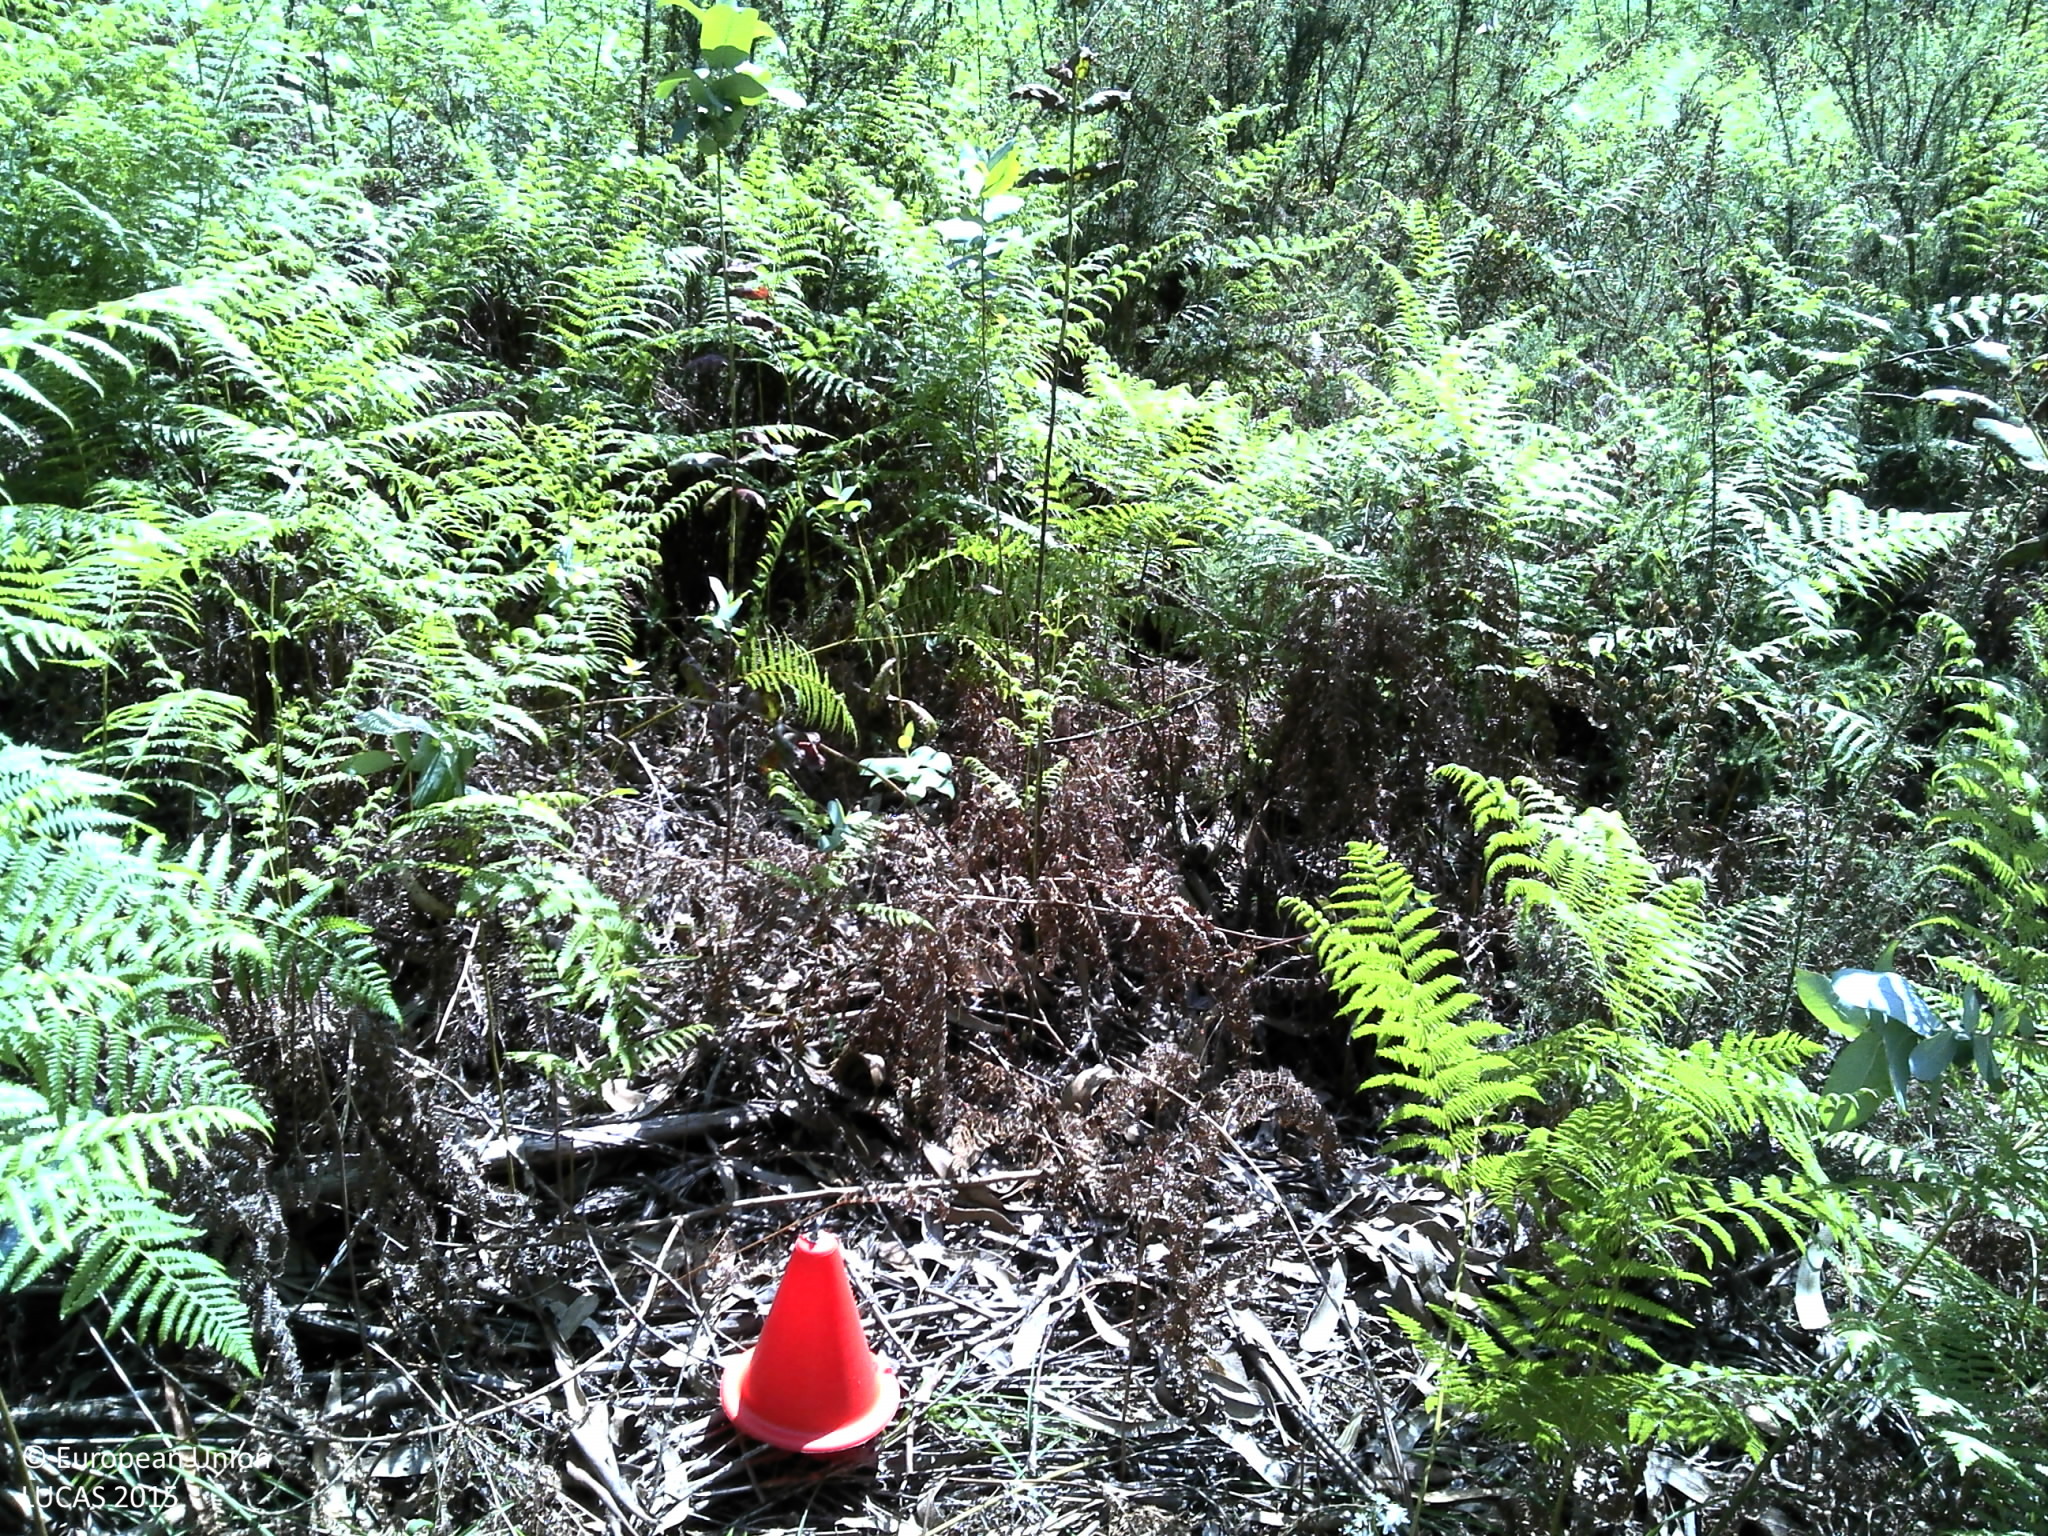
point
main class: Woodland
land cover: Broadleaved woodland
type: exotic forest
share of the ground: 50 - 75 %
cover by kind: broadleaved forest trees 70 %, shrubs 30 %
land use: Forestry
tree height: > 5 m
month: May
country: PT
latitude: 41.2564
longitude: -8.5441
